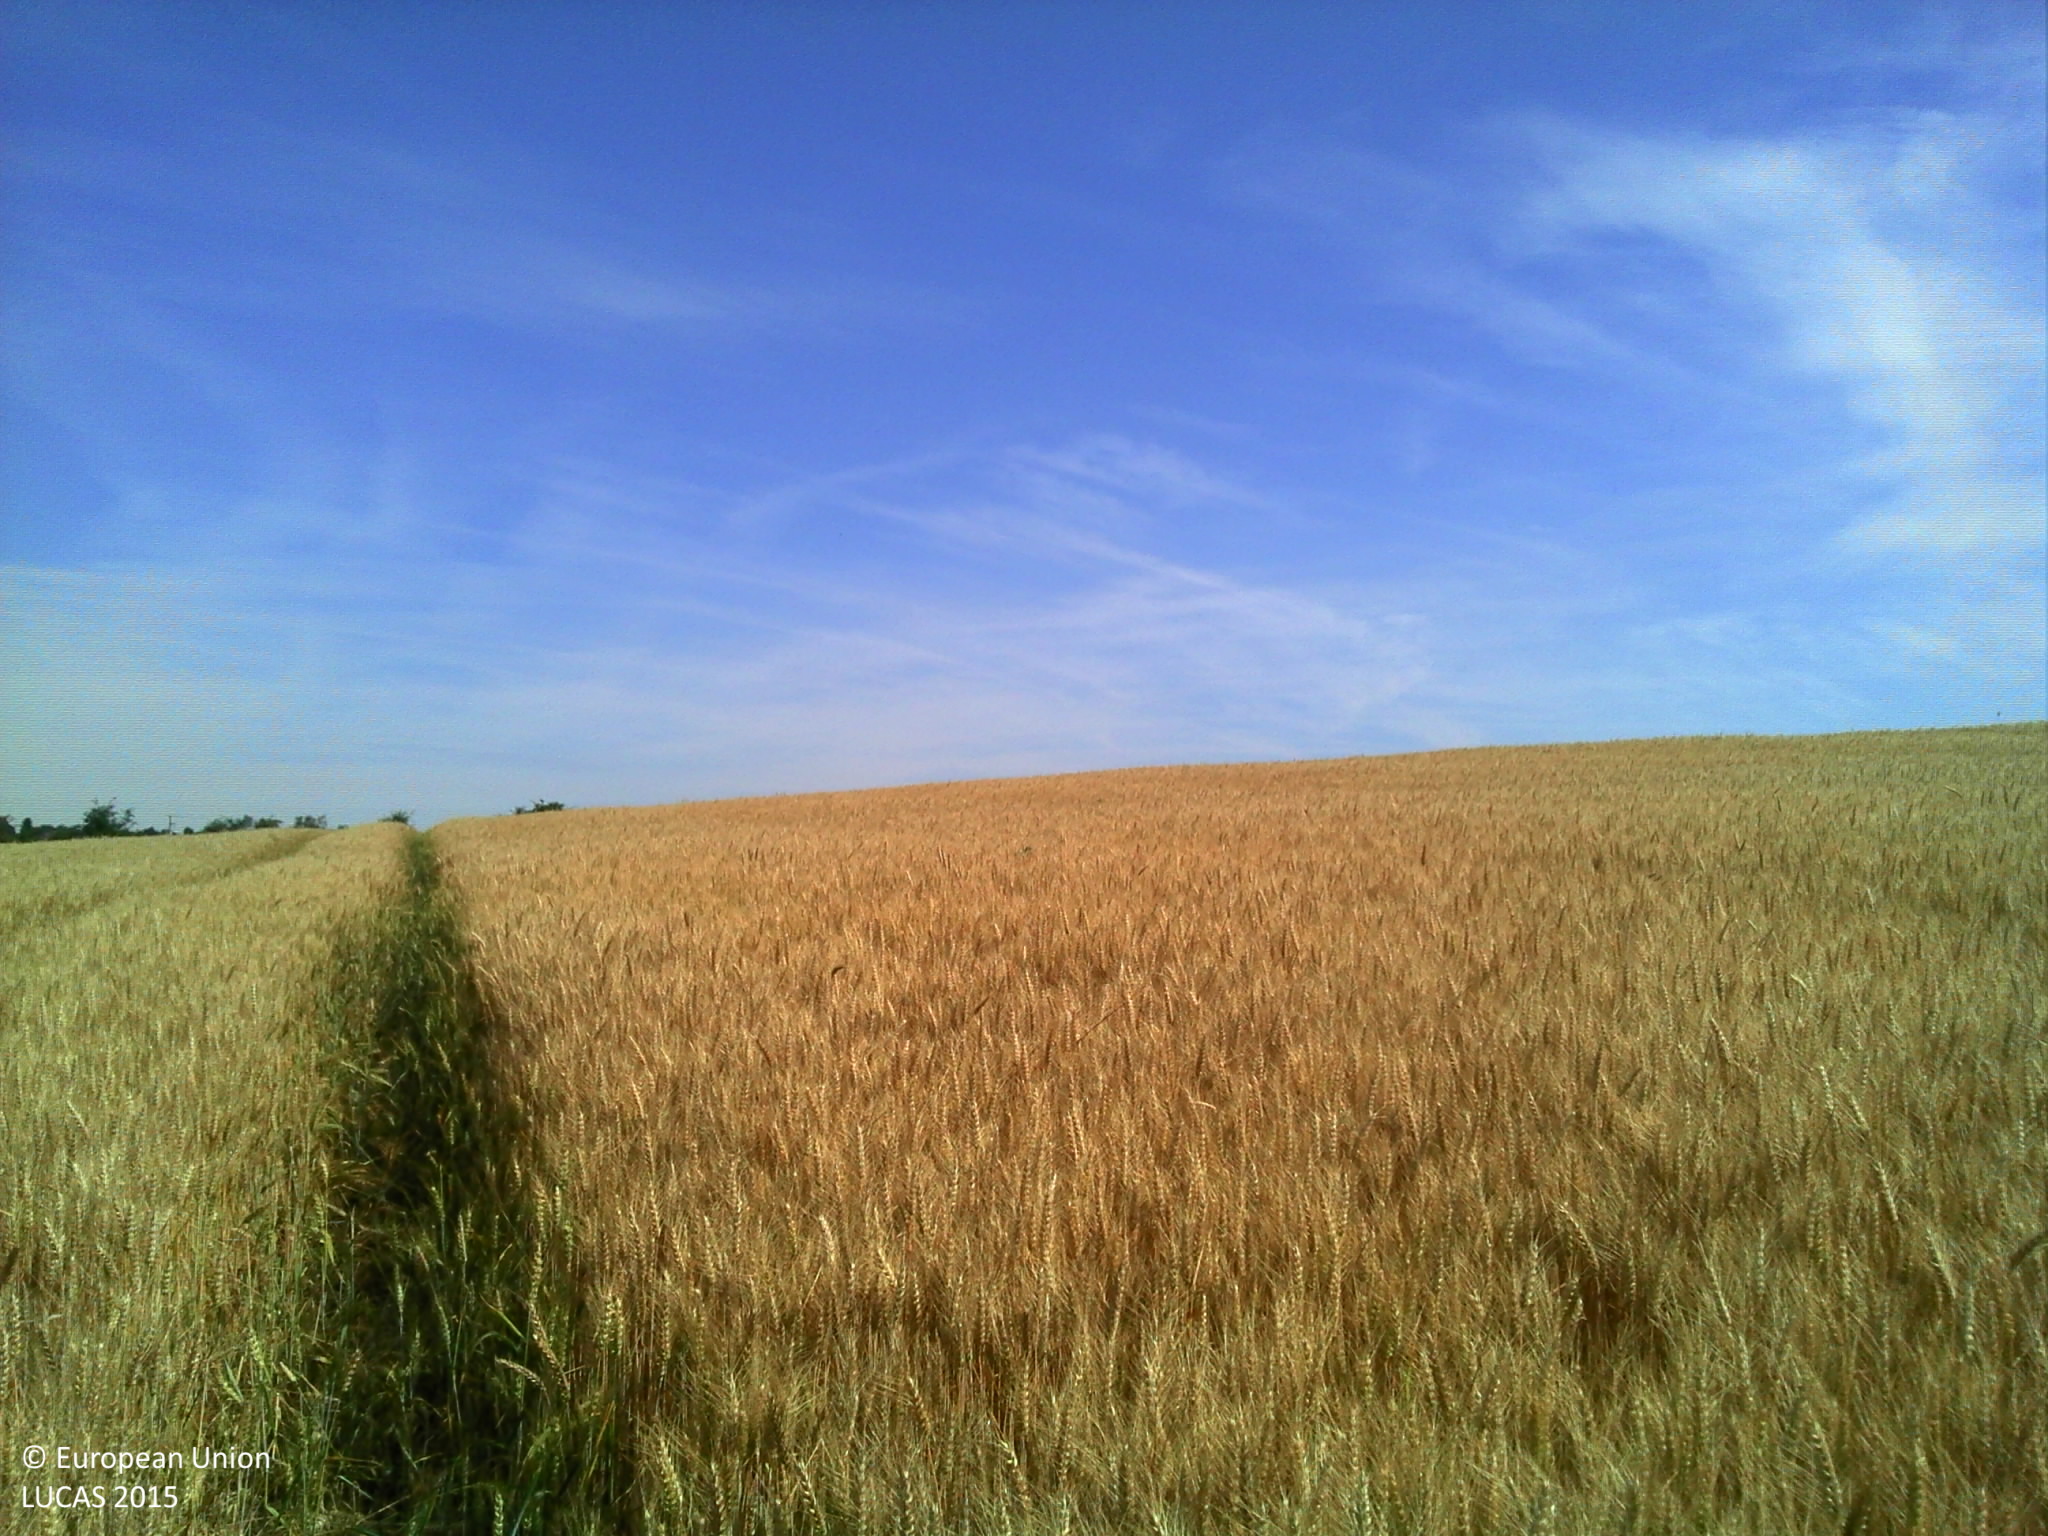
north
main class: Cropland
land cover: Common wheat
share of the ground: > 75 %
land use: Agriculture (excluding fallow land and kitchen gardens)
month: June
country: FR
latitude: 46.2653
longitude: 3.2650
